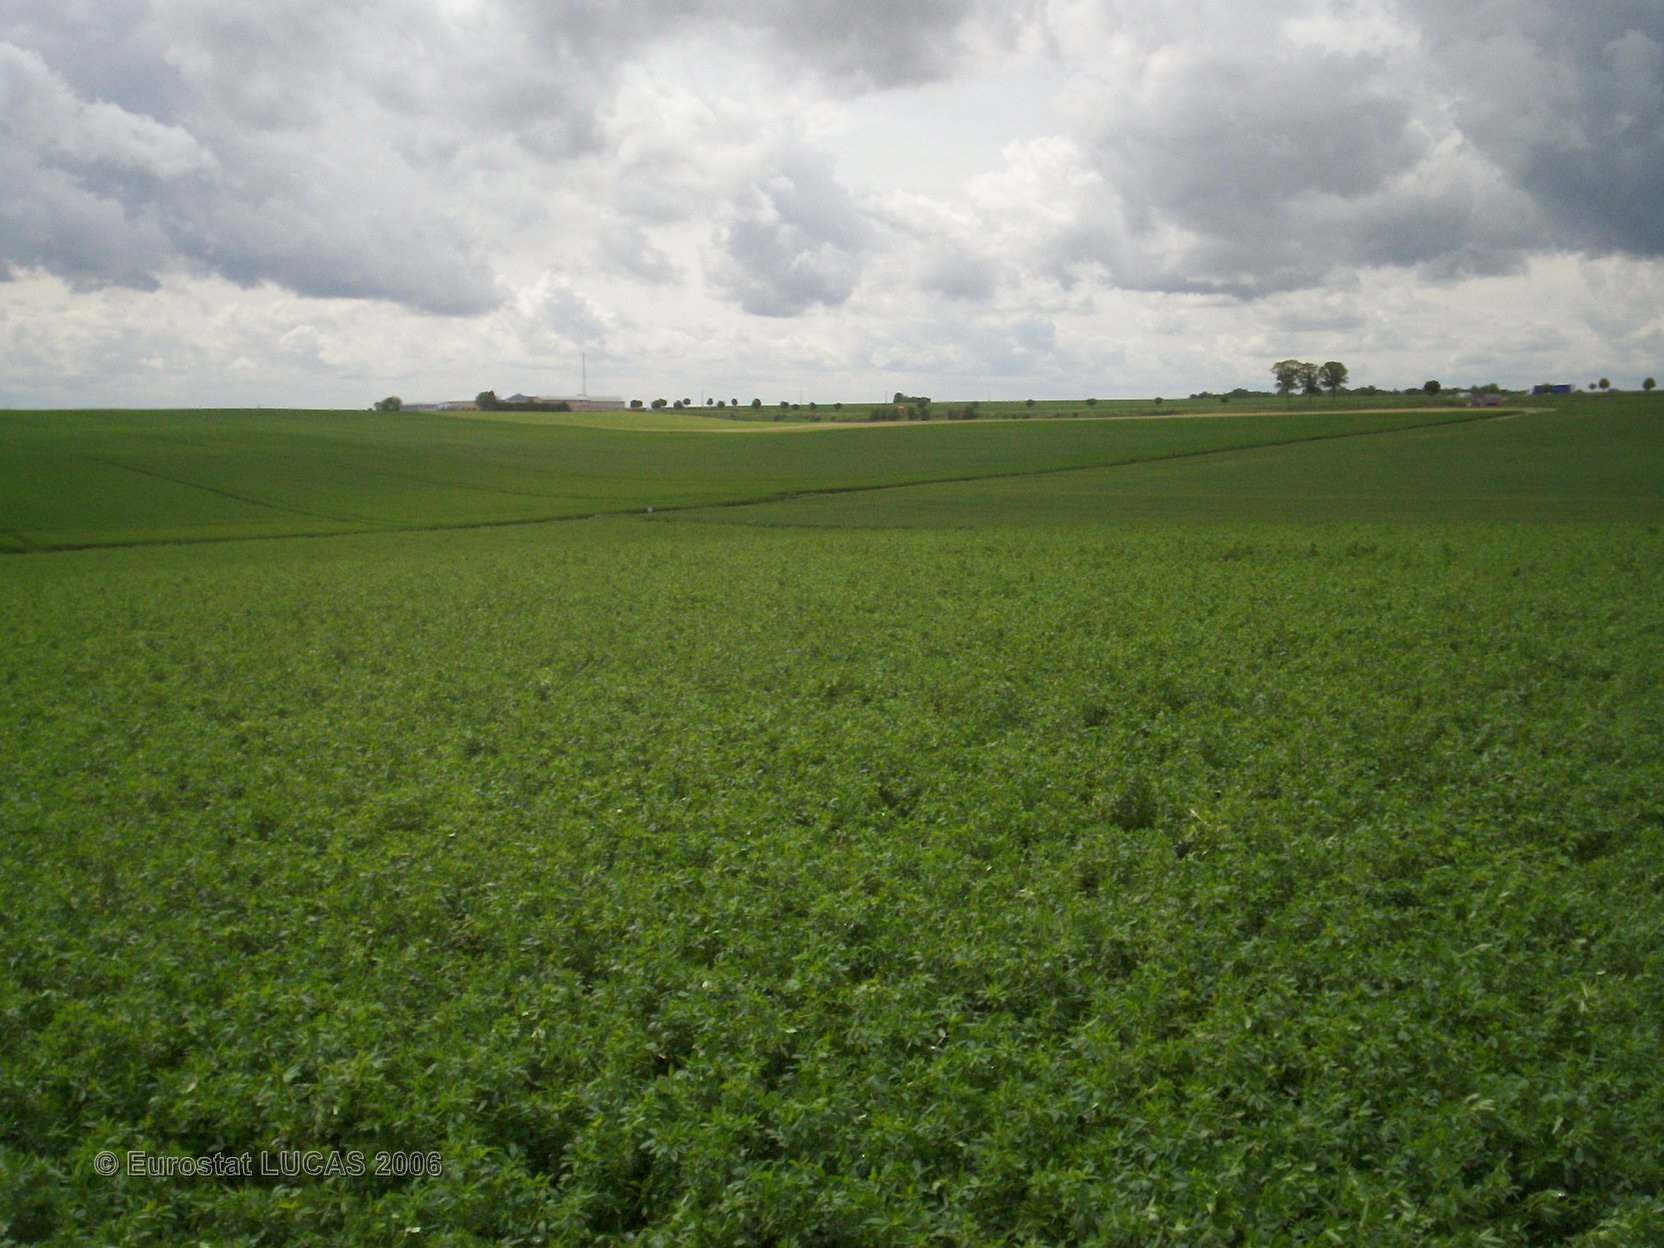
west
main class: Cropland
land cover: Lucerne
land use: Agriculture (excluding fallow land and kitchen gardens)
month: May
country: FR
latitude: 49.4660
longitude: 4.3246
